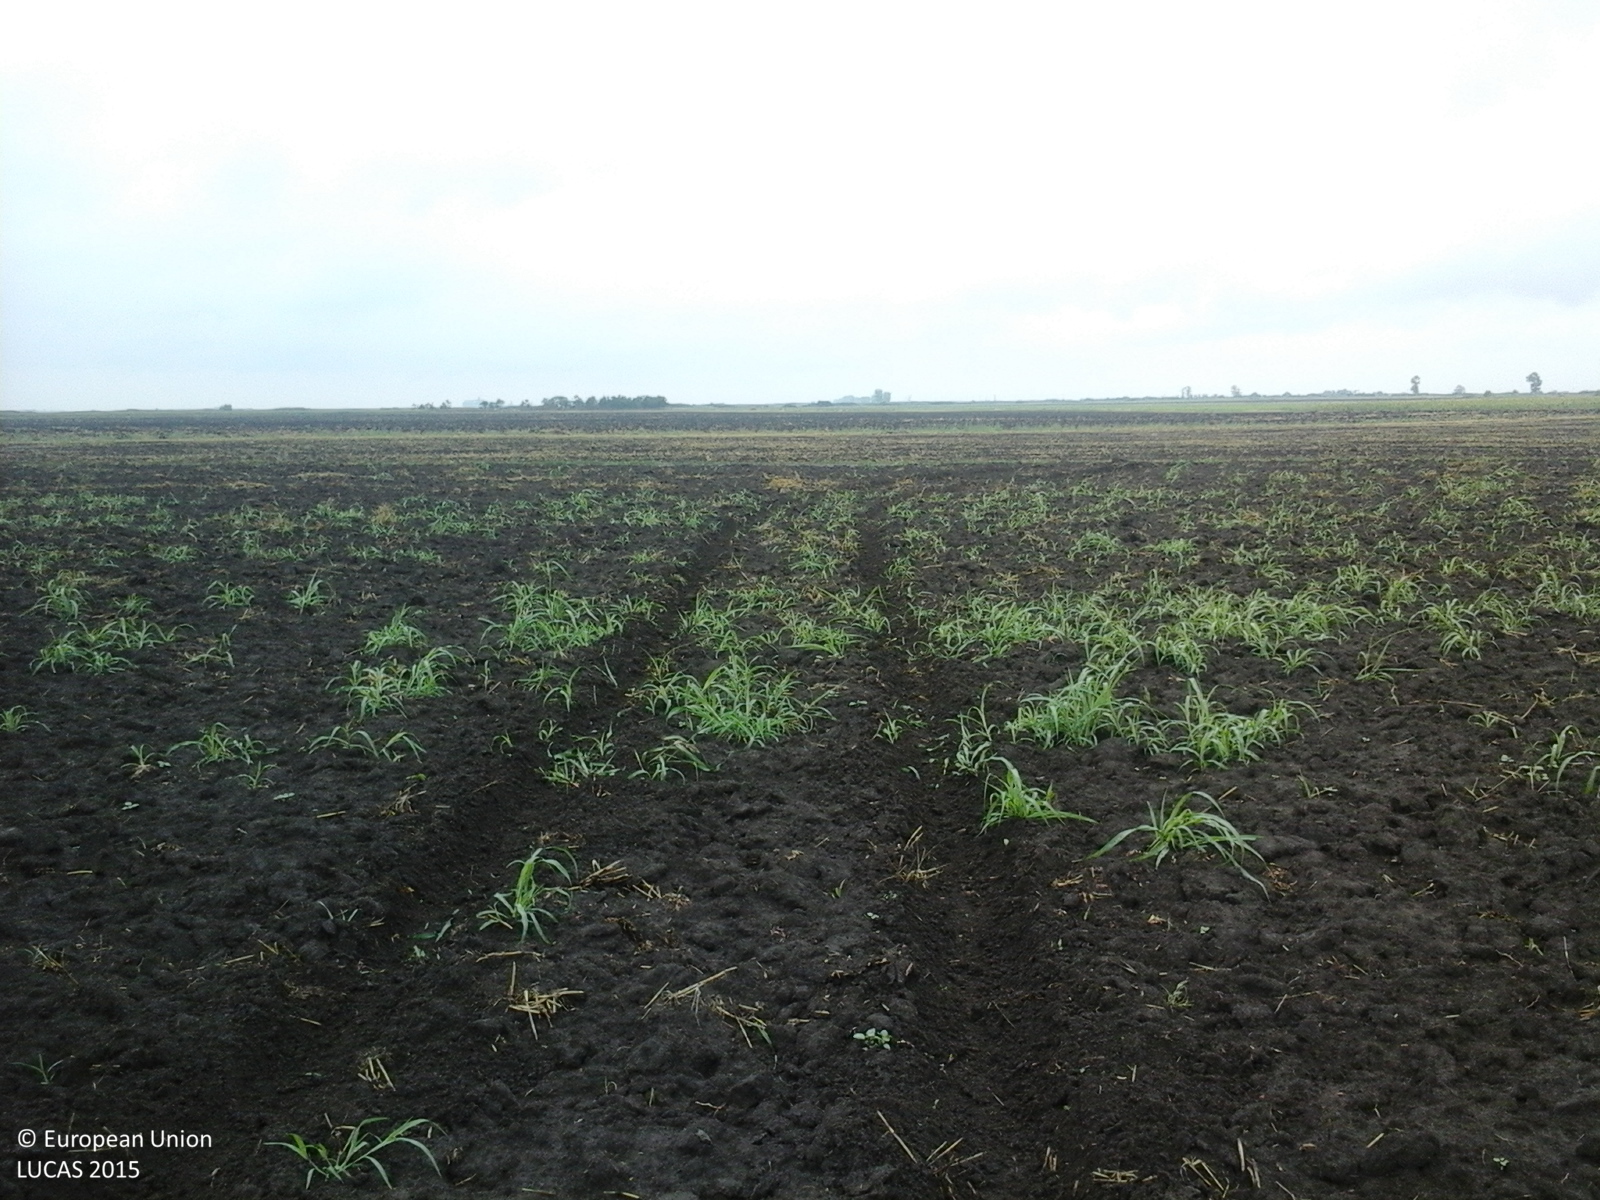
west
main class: Cropland
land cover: Common wheat
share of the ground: < 10 %
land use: Agriculture (excluding fallow land and kitchen gardens)
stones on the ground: < 10 %
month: August
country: RO
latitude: 46.0172
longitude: 20.4733
